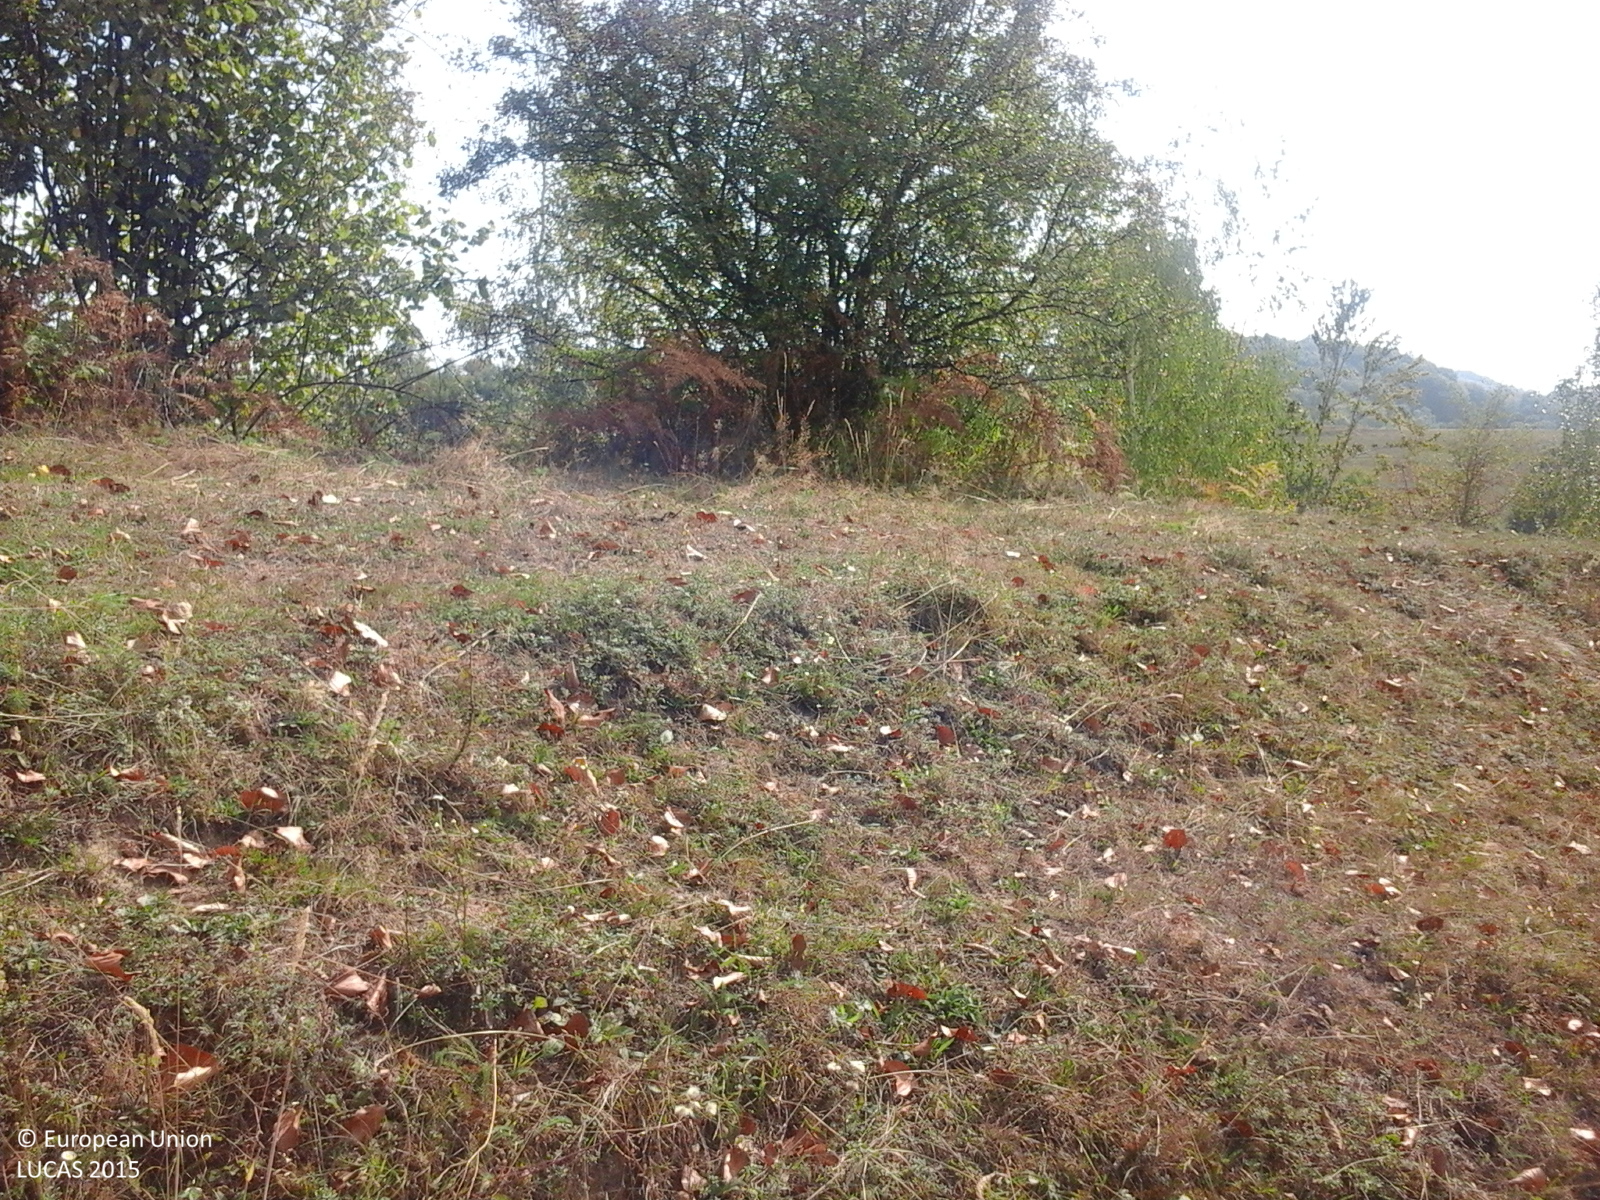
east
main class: Grassland
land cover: Grassland without tree/shrub cover
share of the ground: > 75 %
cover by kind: herbaceous plants 100 %
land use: Agriculture (excluding fallow land and kitchen gardens)
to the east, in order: Grassland without tree/shrub cover; Grassland with sparse tree/shrub cover; Tracks; Broadleaved woodland; Grassland without tree/shrub cover; Grassland with sparse tree/shrub cover; Shrubland with sparse tree cover; Tracks; Shrubland with sparse tree cover
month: September
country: RO
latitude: 47.4353
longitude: 23.9914
